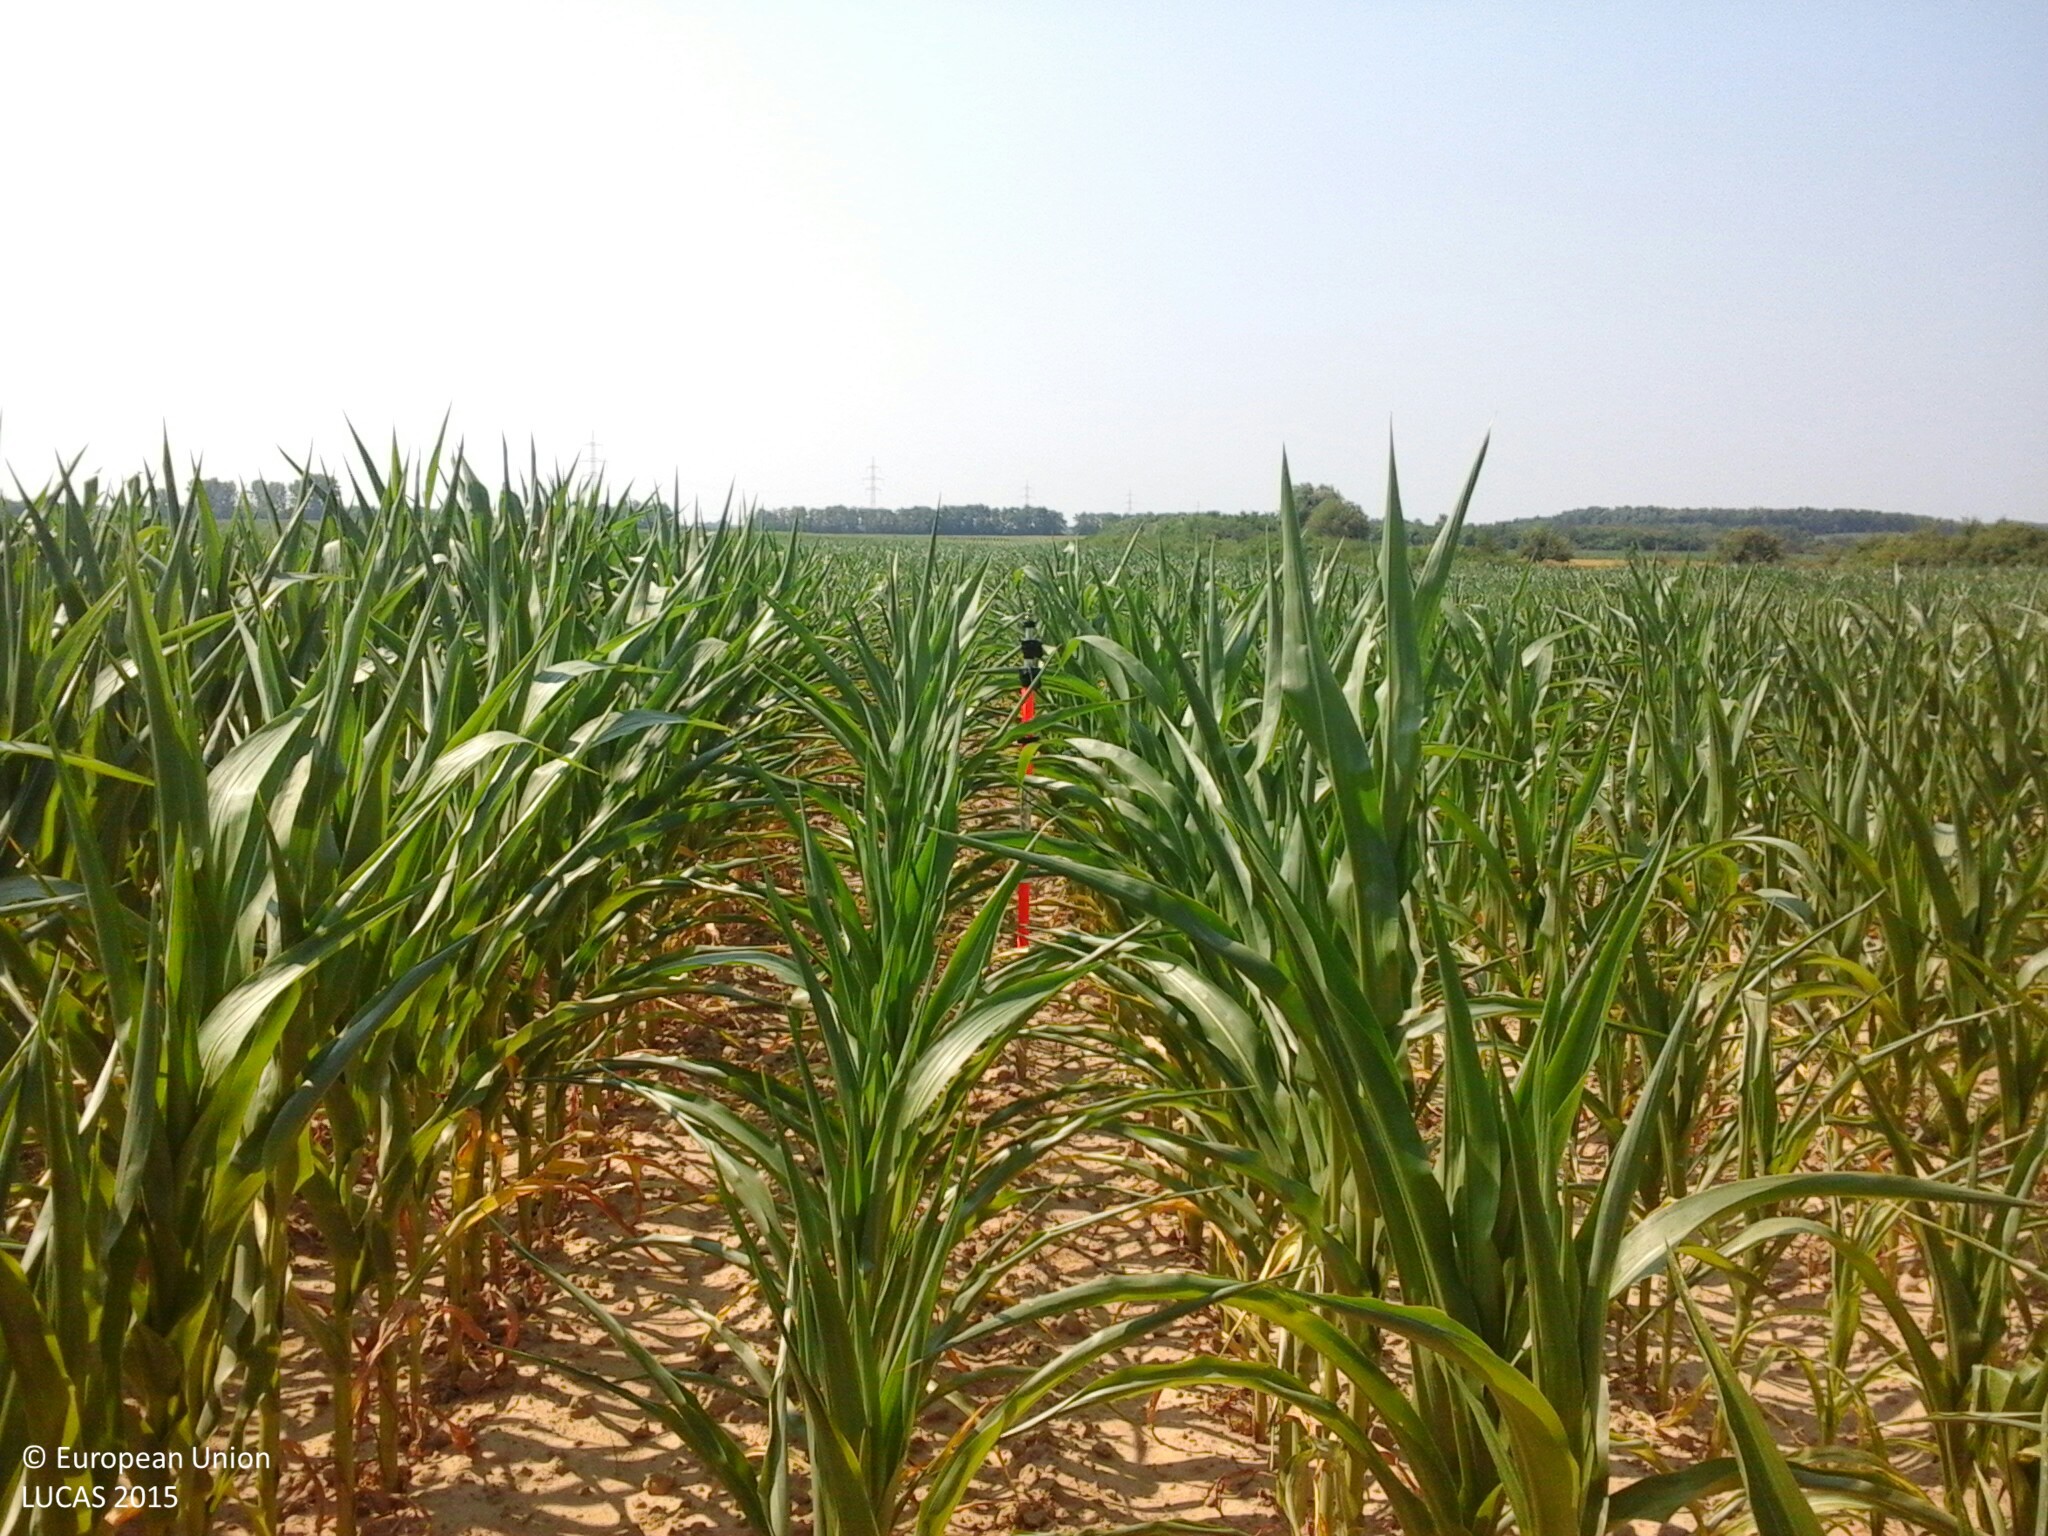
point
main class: Cropland
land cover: Maize
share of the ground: 50 - 75 %
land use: Agriculture (excluding fallow land and kitchen gardens)
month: July
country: HU
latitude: 48.2920
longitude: 22.1732
